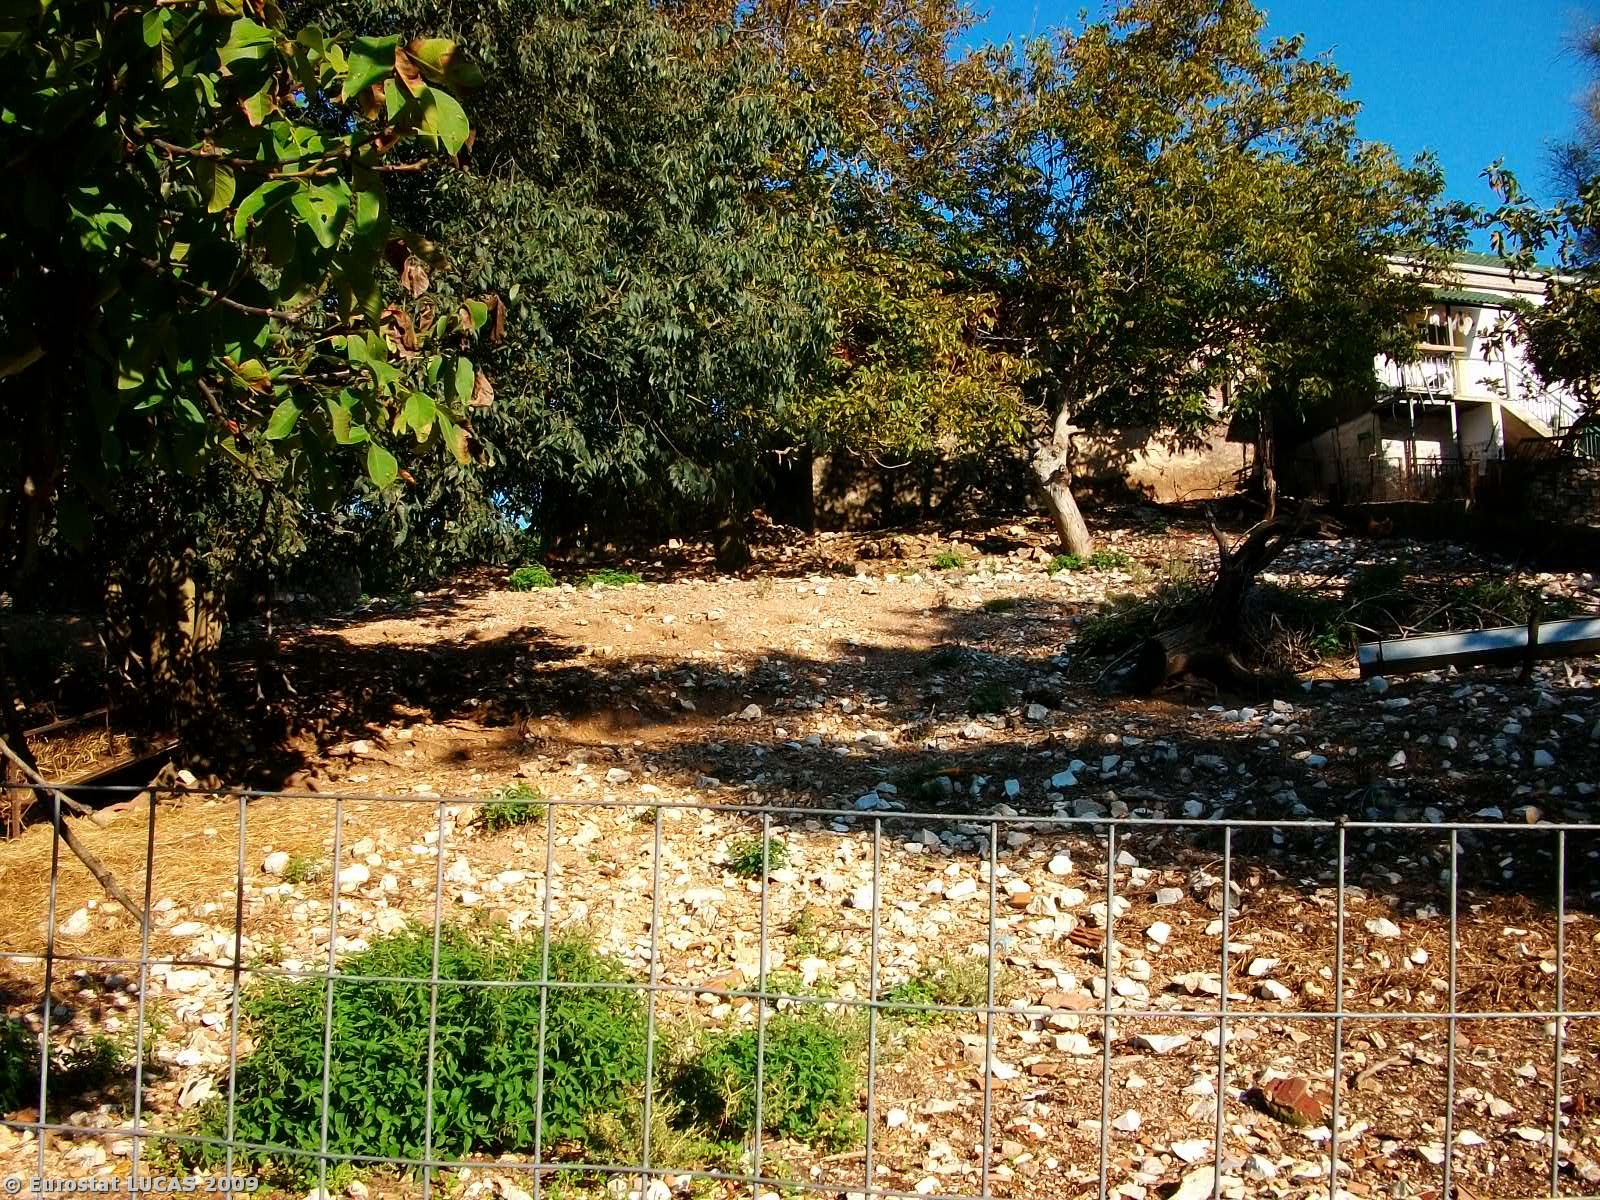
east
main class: Cropland
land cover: Nuts trees
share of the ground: 25 - 50 %
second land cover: Bare land
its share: > 75 %
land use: Kitchen garden
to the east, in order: Nuts trees; Bare land; Artificial constructions in urban areas; Fences; Olive groves; Grassland with sparse tree/shrub cover; Ditches and canals; Shrubland without tree cover
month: October
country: GR
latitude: 39.3942
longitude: 20.4820
